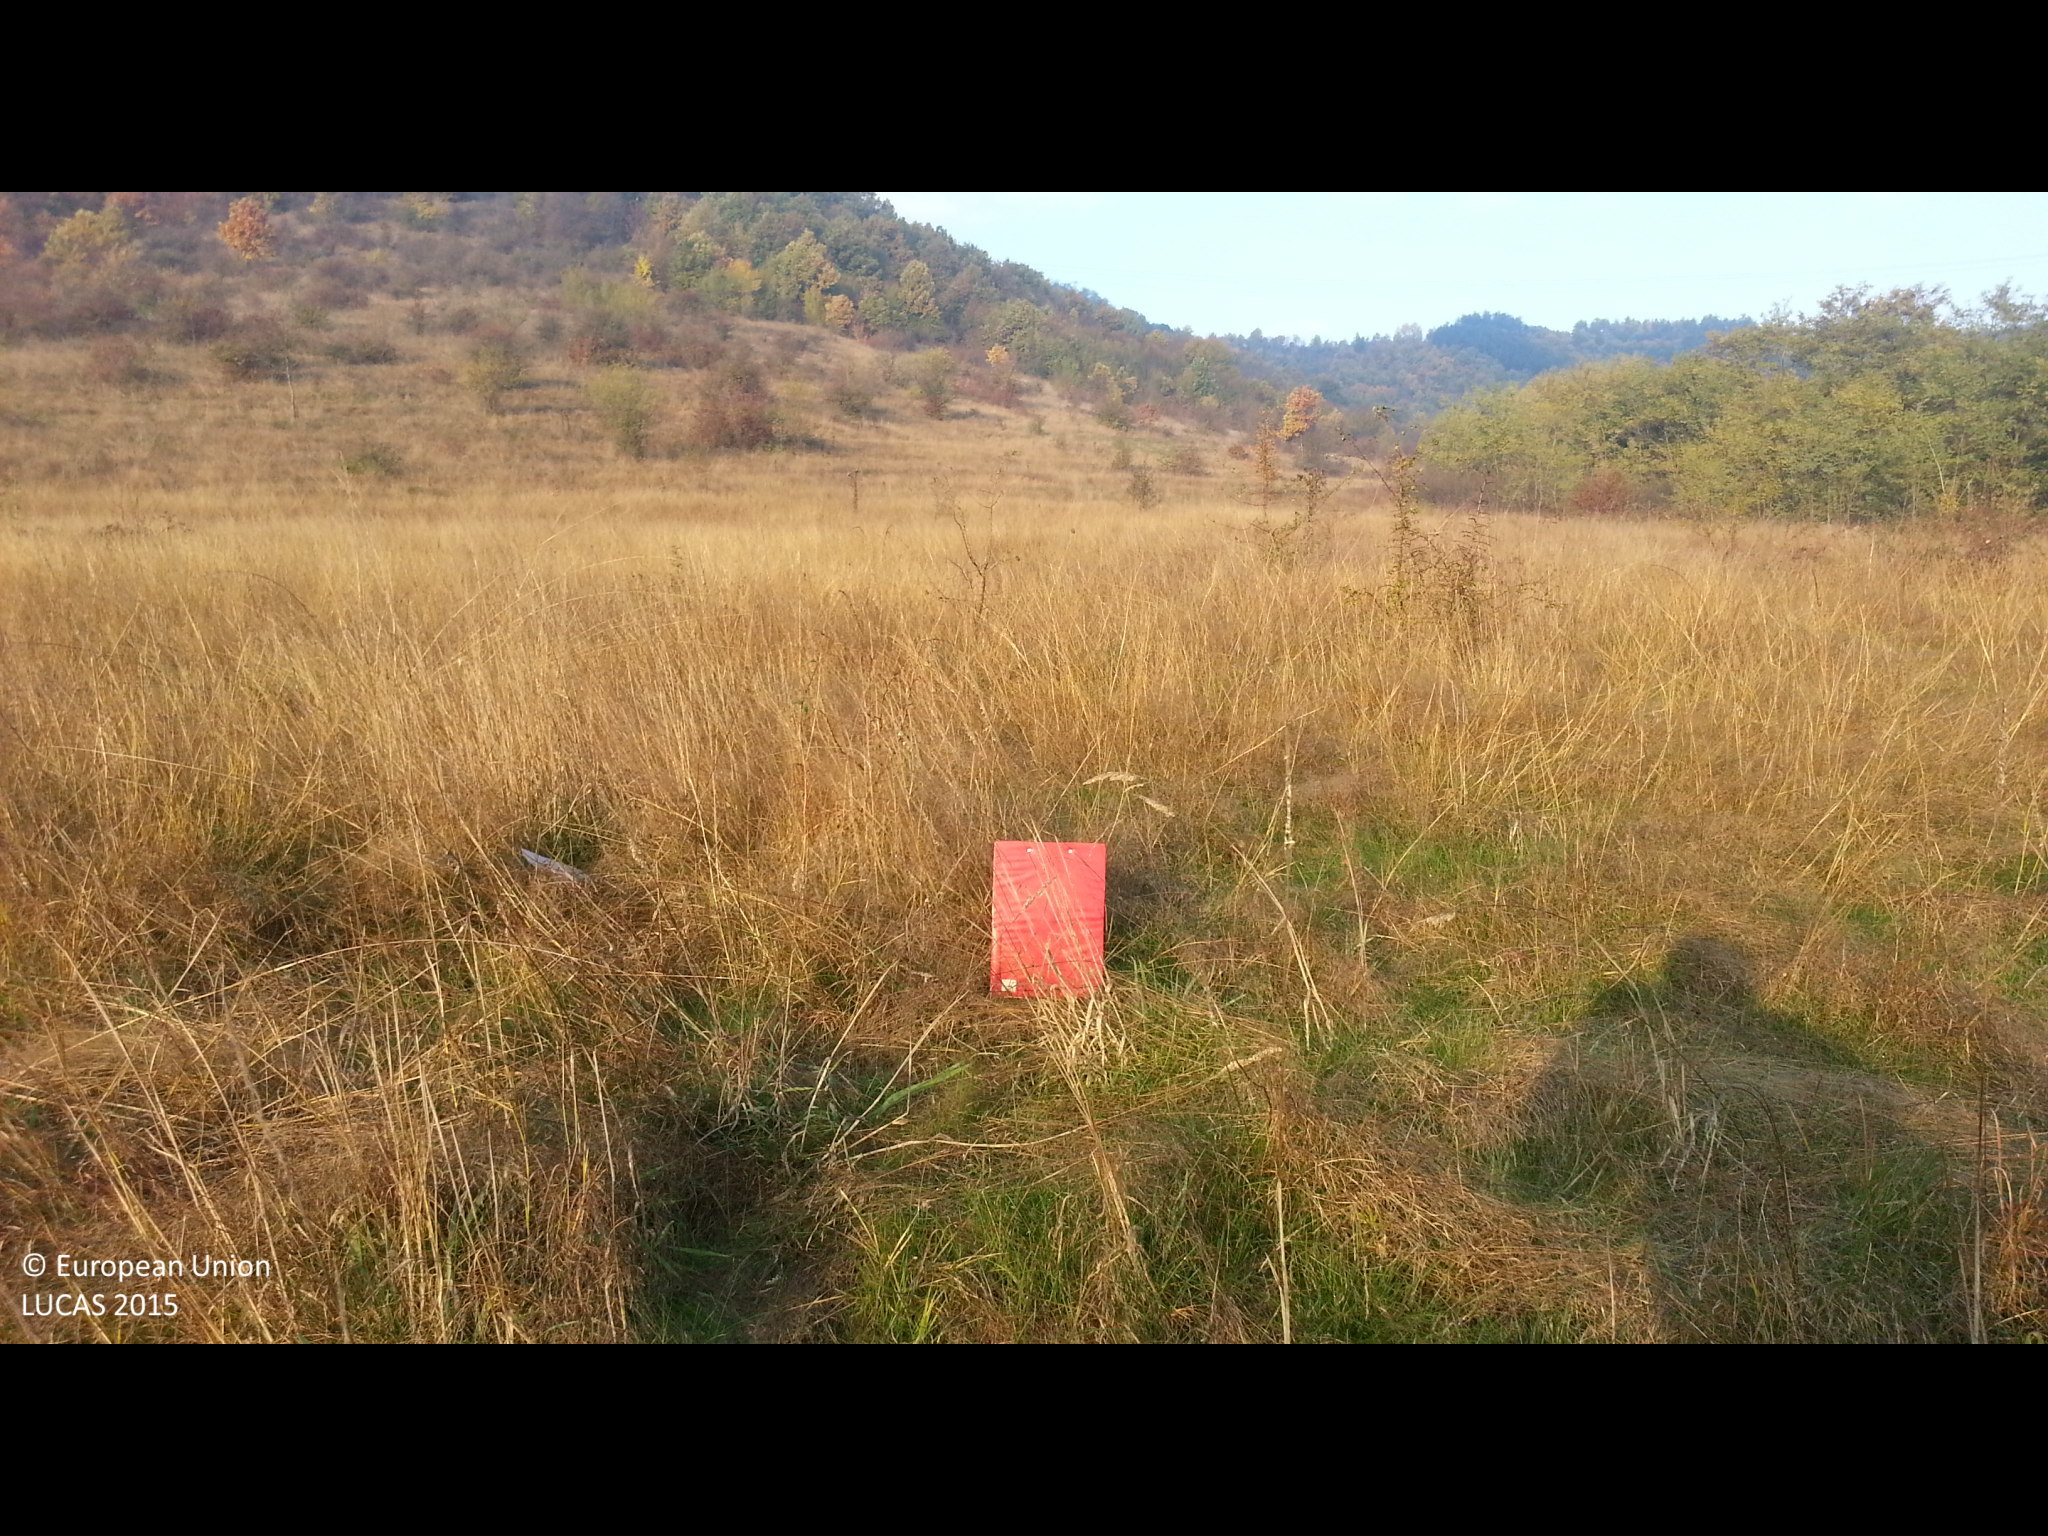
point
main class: Grassland
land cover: Grassland without tree/shrub cover
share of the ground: > 75 %
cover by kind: herbaceous plants 100 %
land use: Agriculture (excluding fallow land and kitchen gardens)
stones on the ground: 10 - 25 %
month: November
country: BG
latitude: 42.9536
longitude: 23.7596
